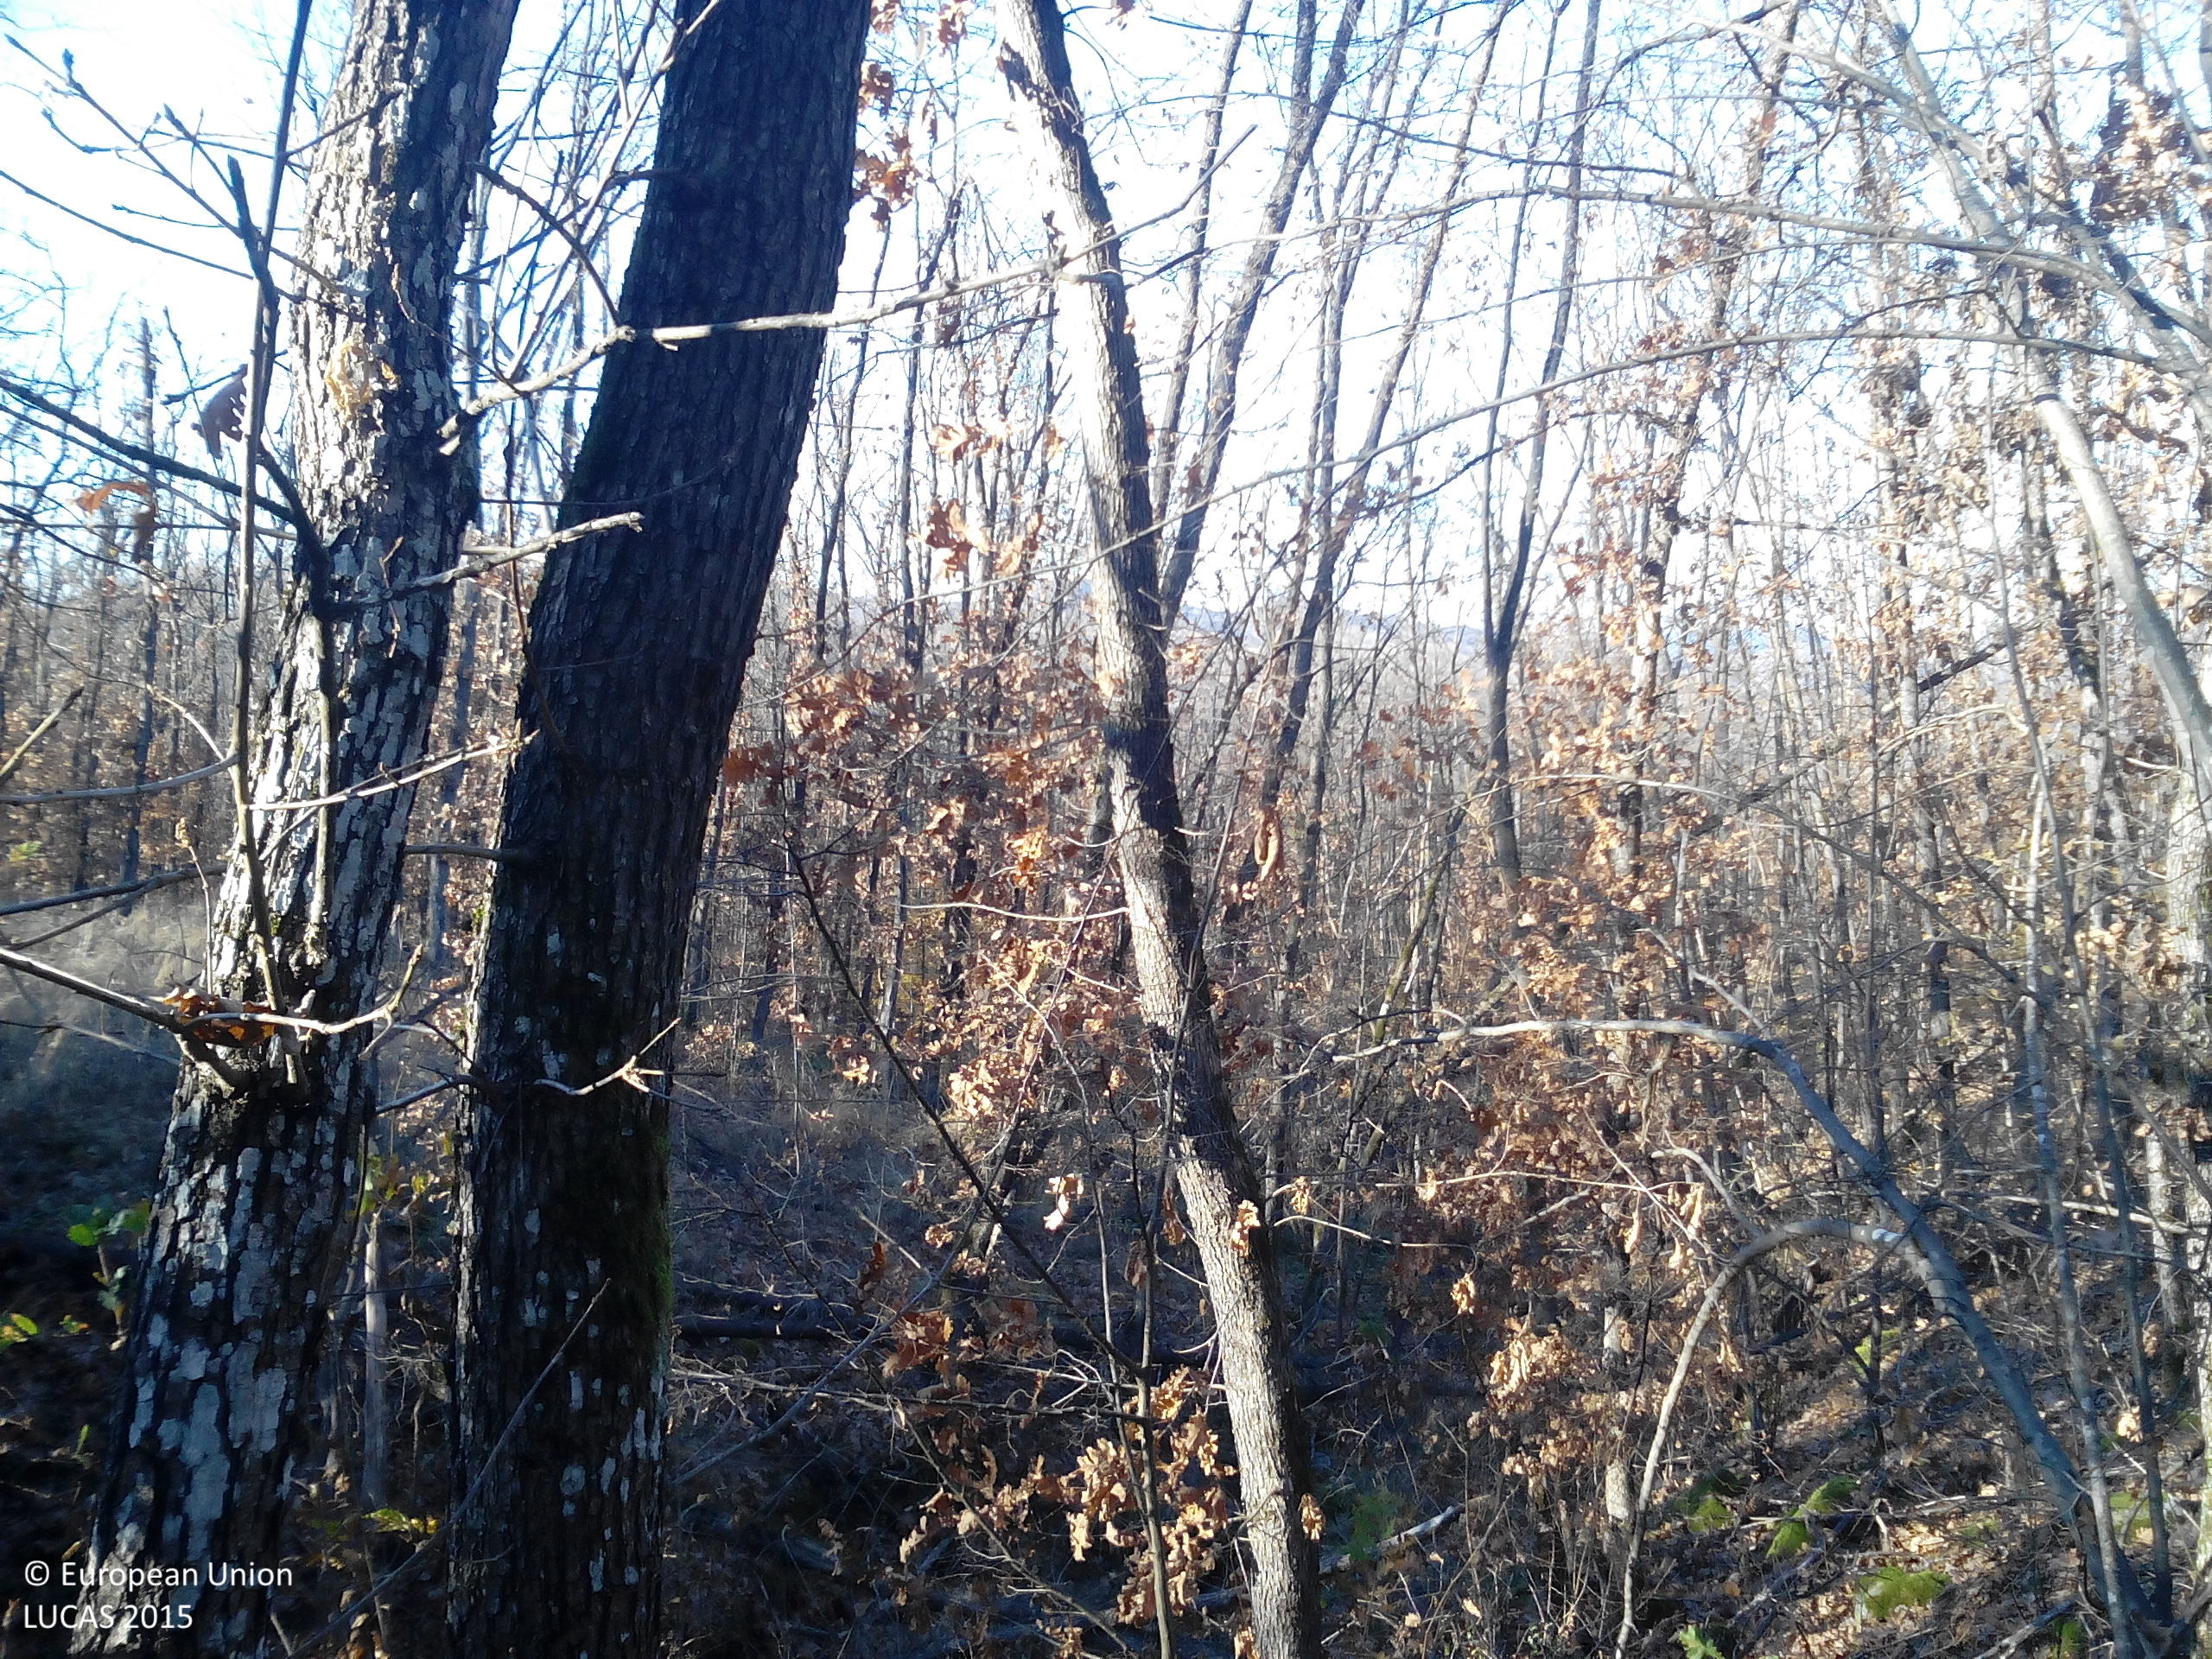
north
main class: Woodland
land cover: Broadleaved woodland
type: mesophytic deciduous forest
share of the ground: > 75 %
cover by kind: broadleaved forest trees 95 %, shrubs 5 %
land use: Forestry
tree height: > 5 m
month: November
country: BG
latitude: 43.0854
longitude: 23.8657
